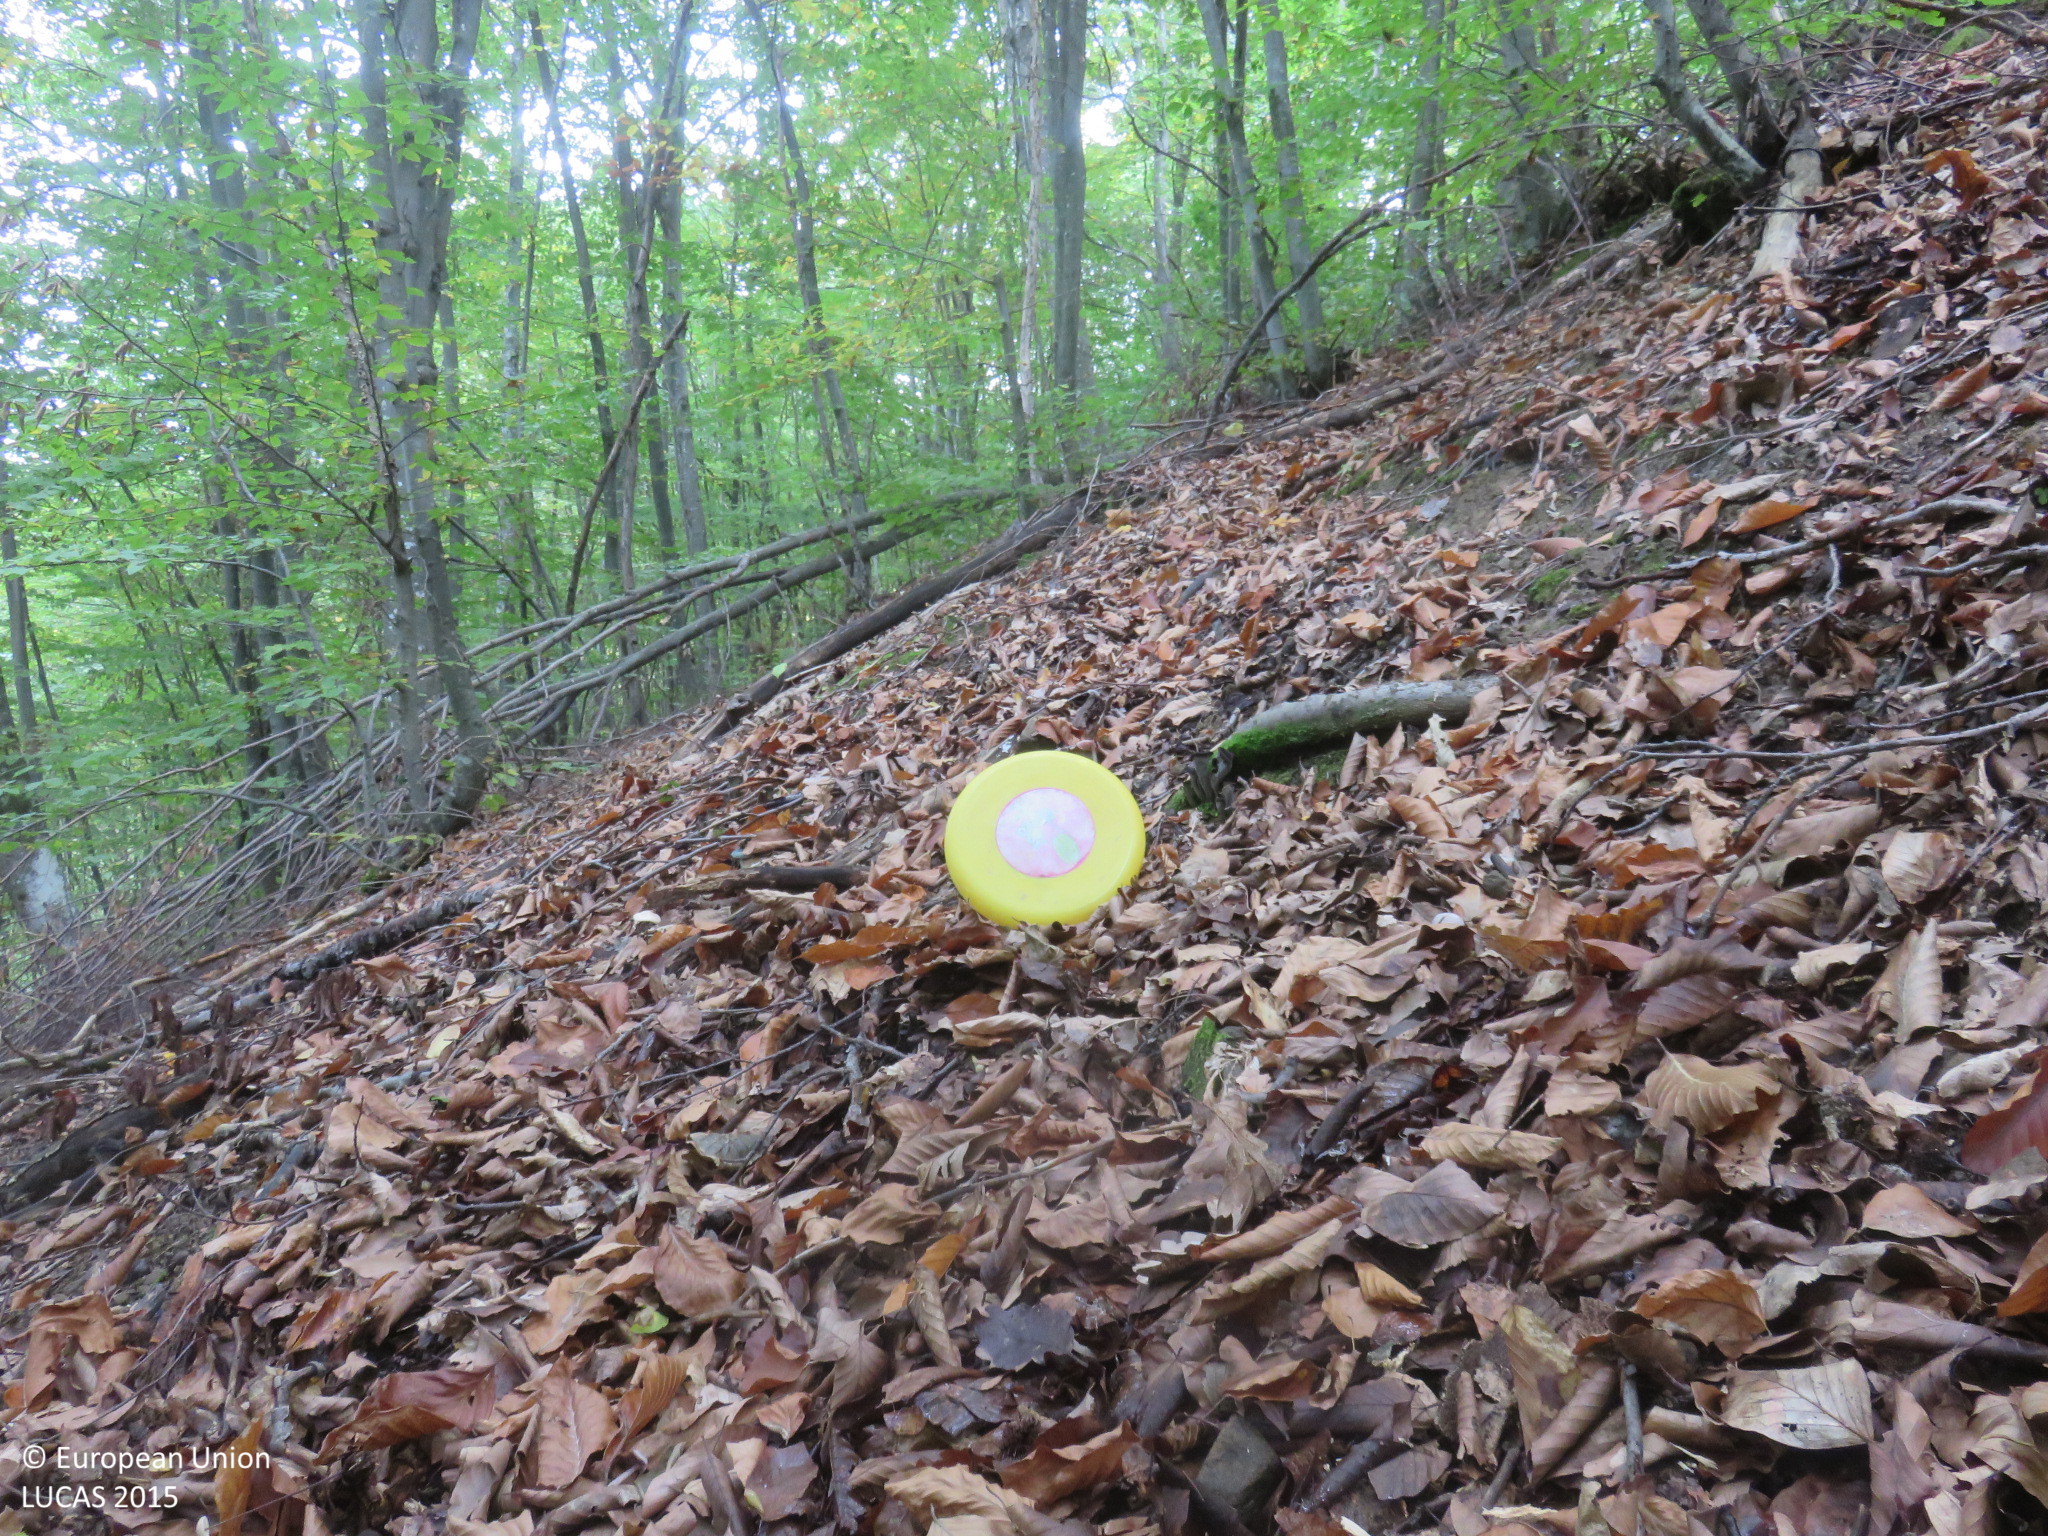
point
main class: Woodland
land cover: Broadleaved woodland
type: beech forest
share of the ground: > 75 %
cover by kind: broadleaved forest trees 85 %, unconsolidated bare surface 10 %, shrubs 5 %
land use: Forestry
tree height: > 5 m
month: October
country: BG
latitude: 42.9090
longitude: 24.9709
